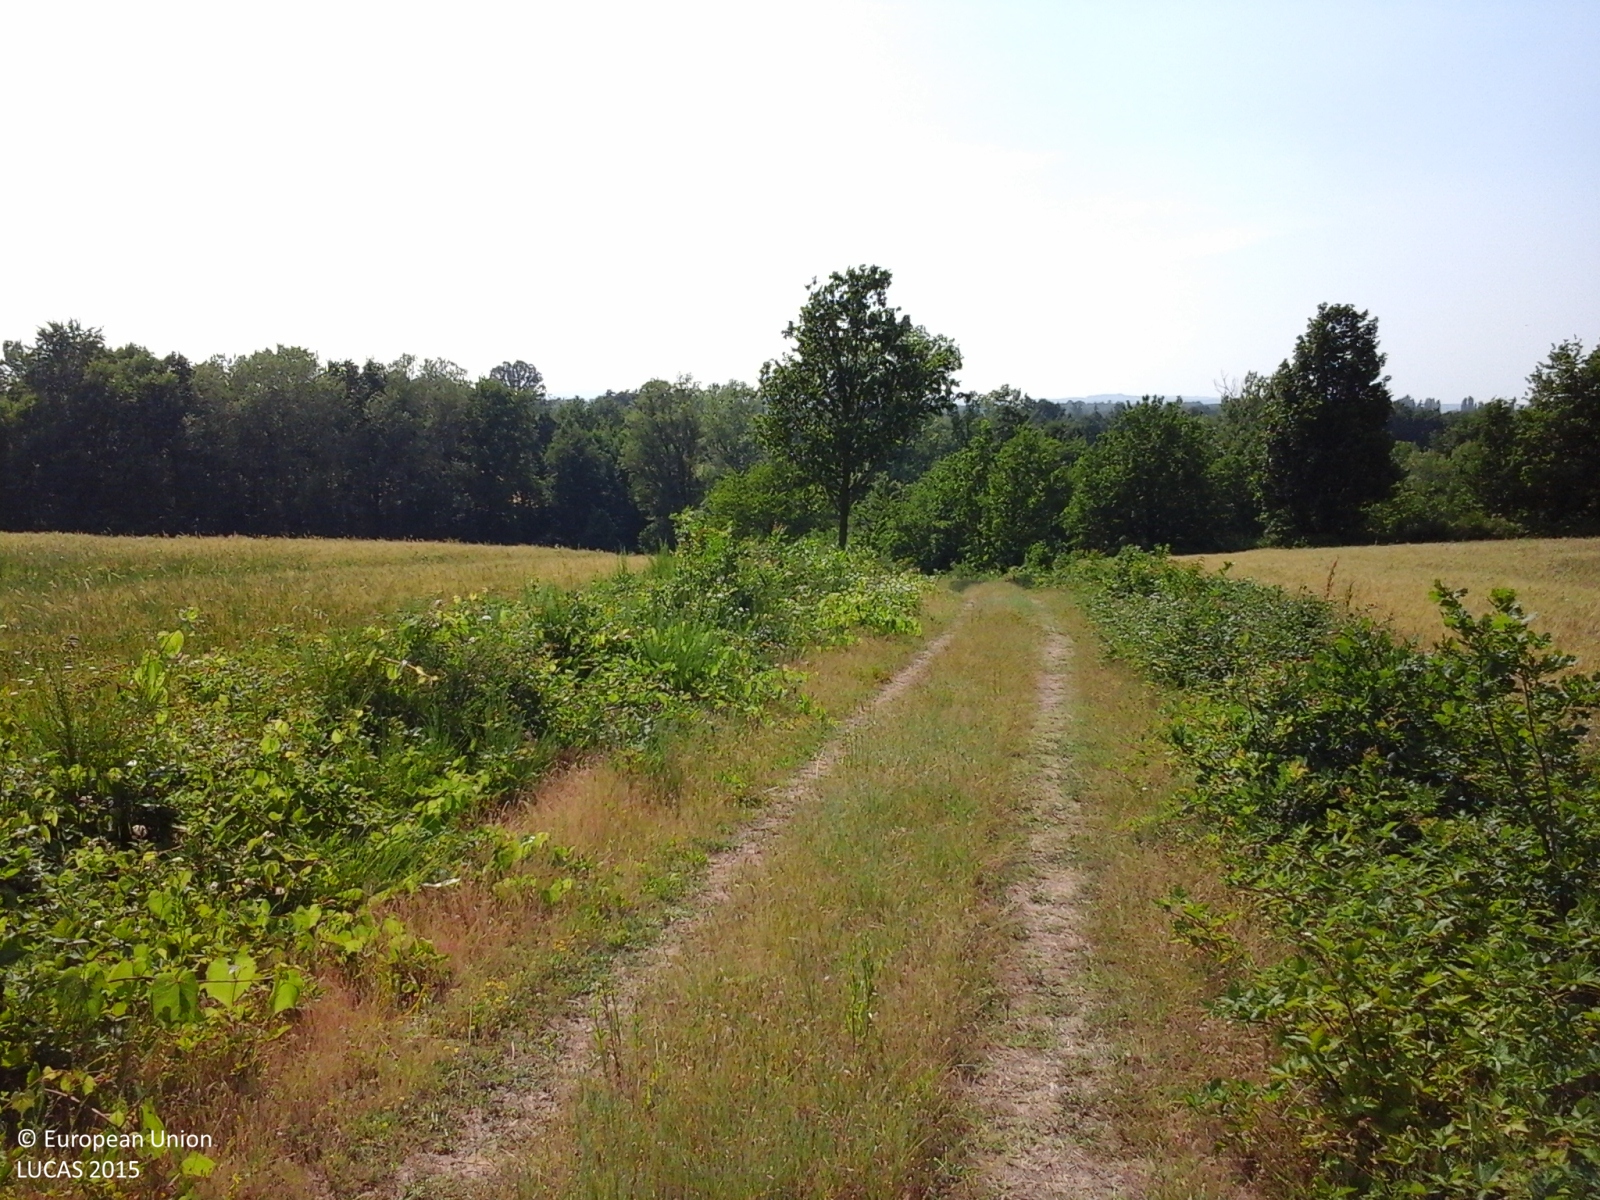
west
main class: Cropland
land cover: Common wheat
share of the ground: > 75 %
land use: Agriculture (excluding fallow land and kitchen gardens)
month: June
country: IT
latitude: 44.7199
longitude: 8.6016
